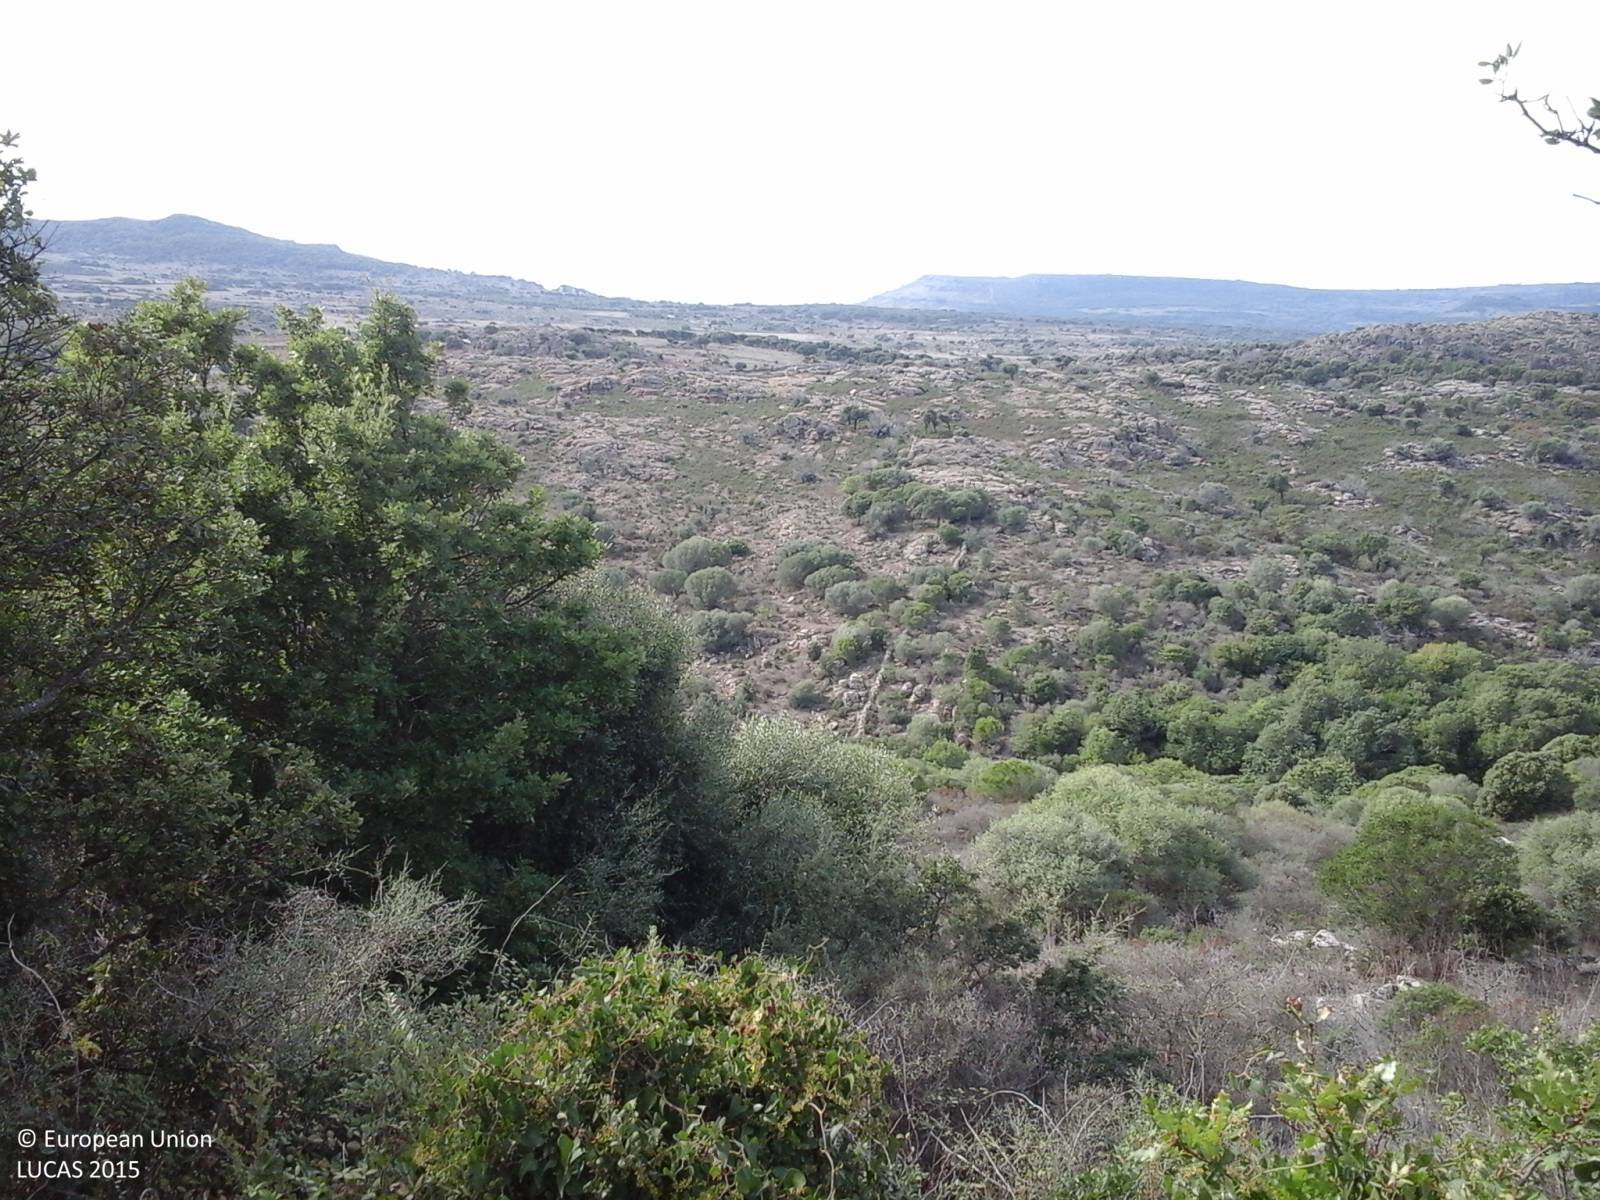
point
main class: Shrubland
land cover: Shrubland with sparse tree cover
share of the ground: > 75 %
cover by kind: shrubs 95 %, broadleaved forest trees 5 %
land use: Semi-natural and natural areas not in use
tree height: < 5 m
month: October
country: IT
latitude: 40.3643
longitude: 8.4886
